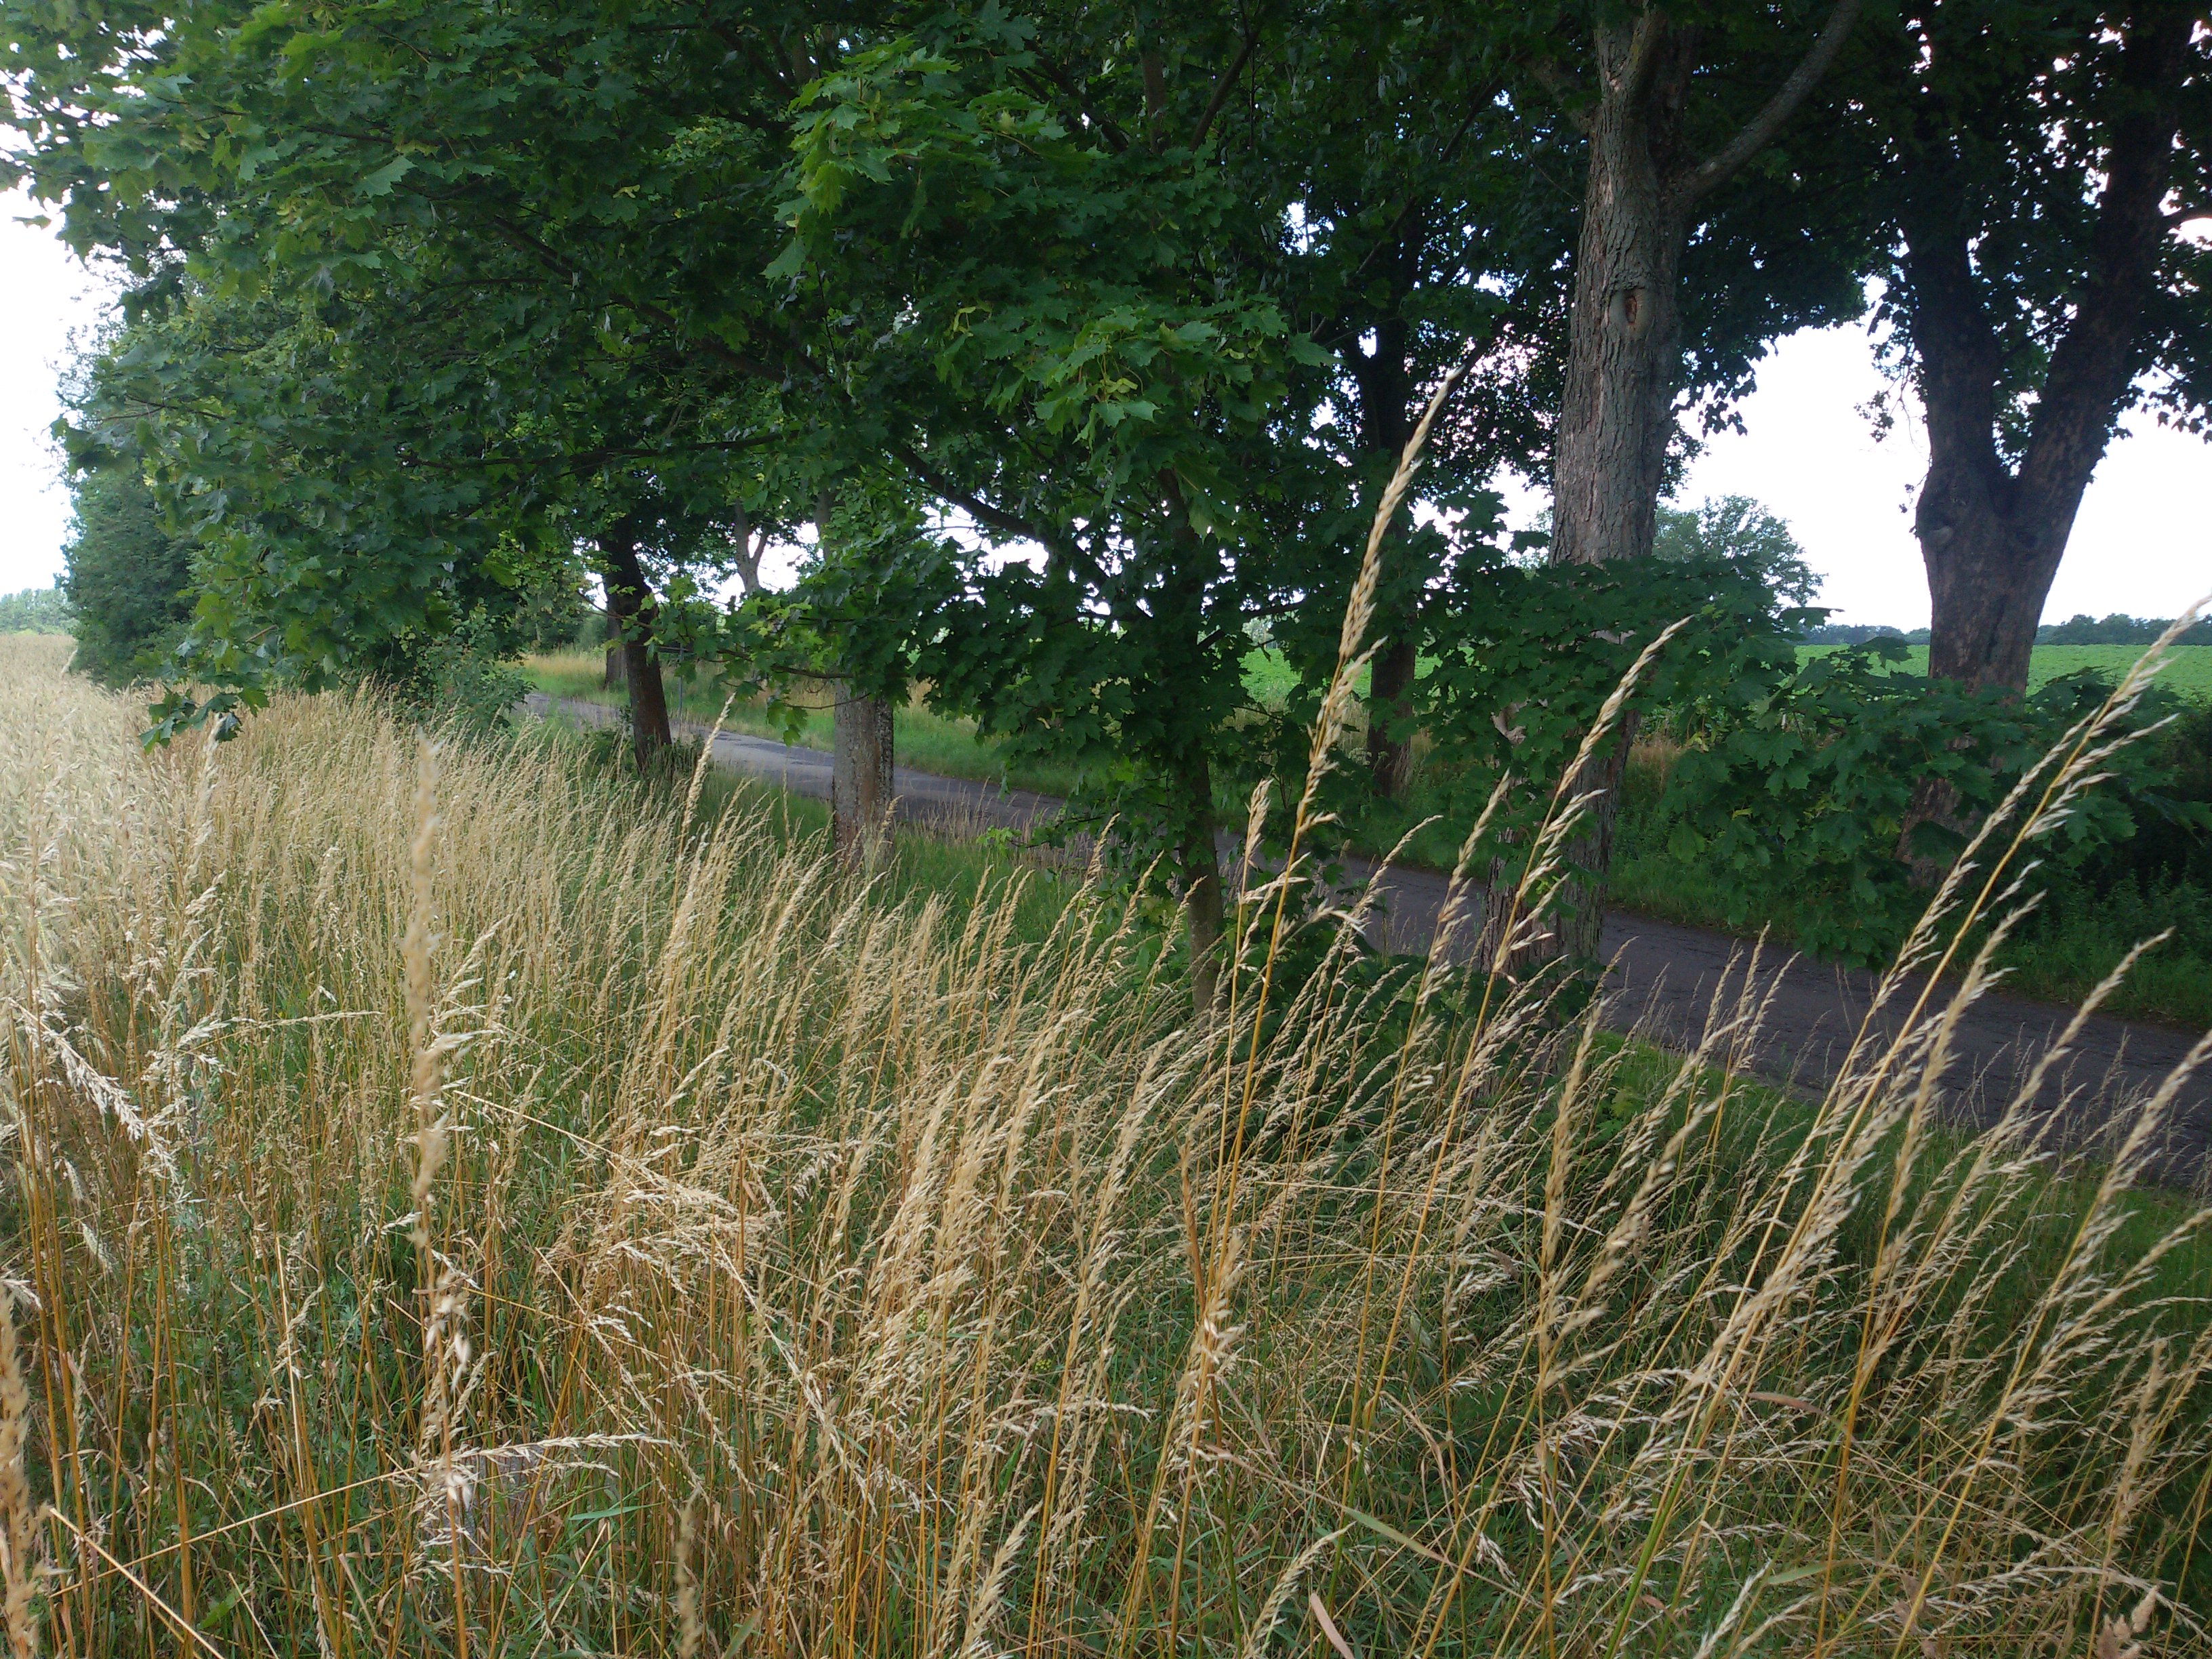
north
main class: Cropland
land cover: Rye
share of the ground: > 75 %
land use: Agriculture (excluding fallow land and kitchen gardens)
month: July
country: PL
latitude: 54.0534
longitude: 15.8543
